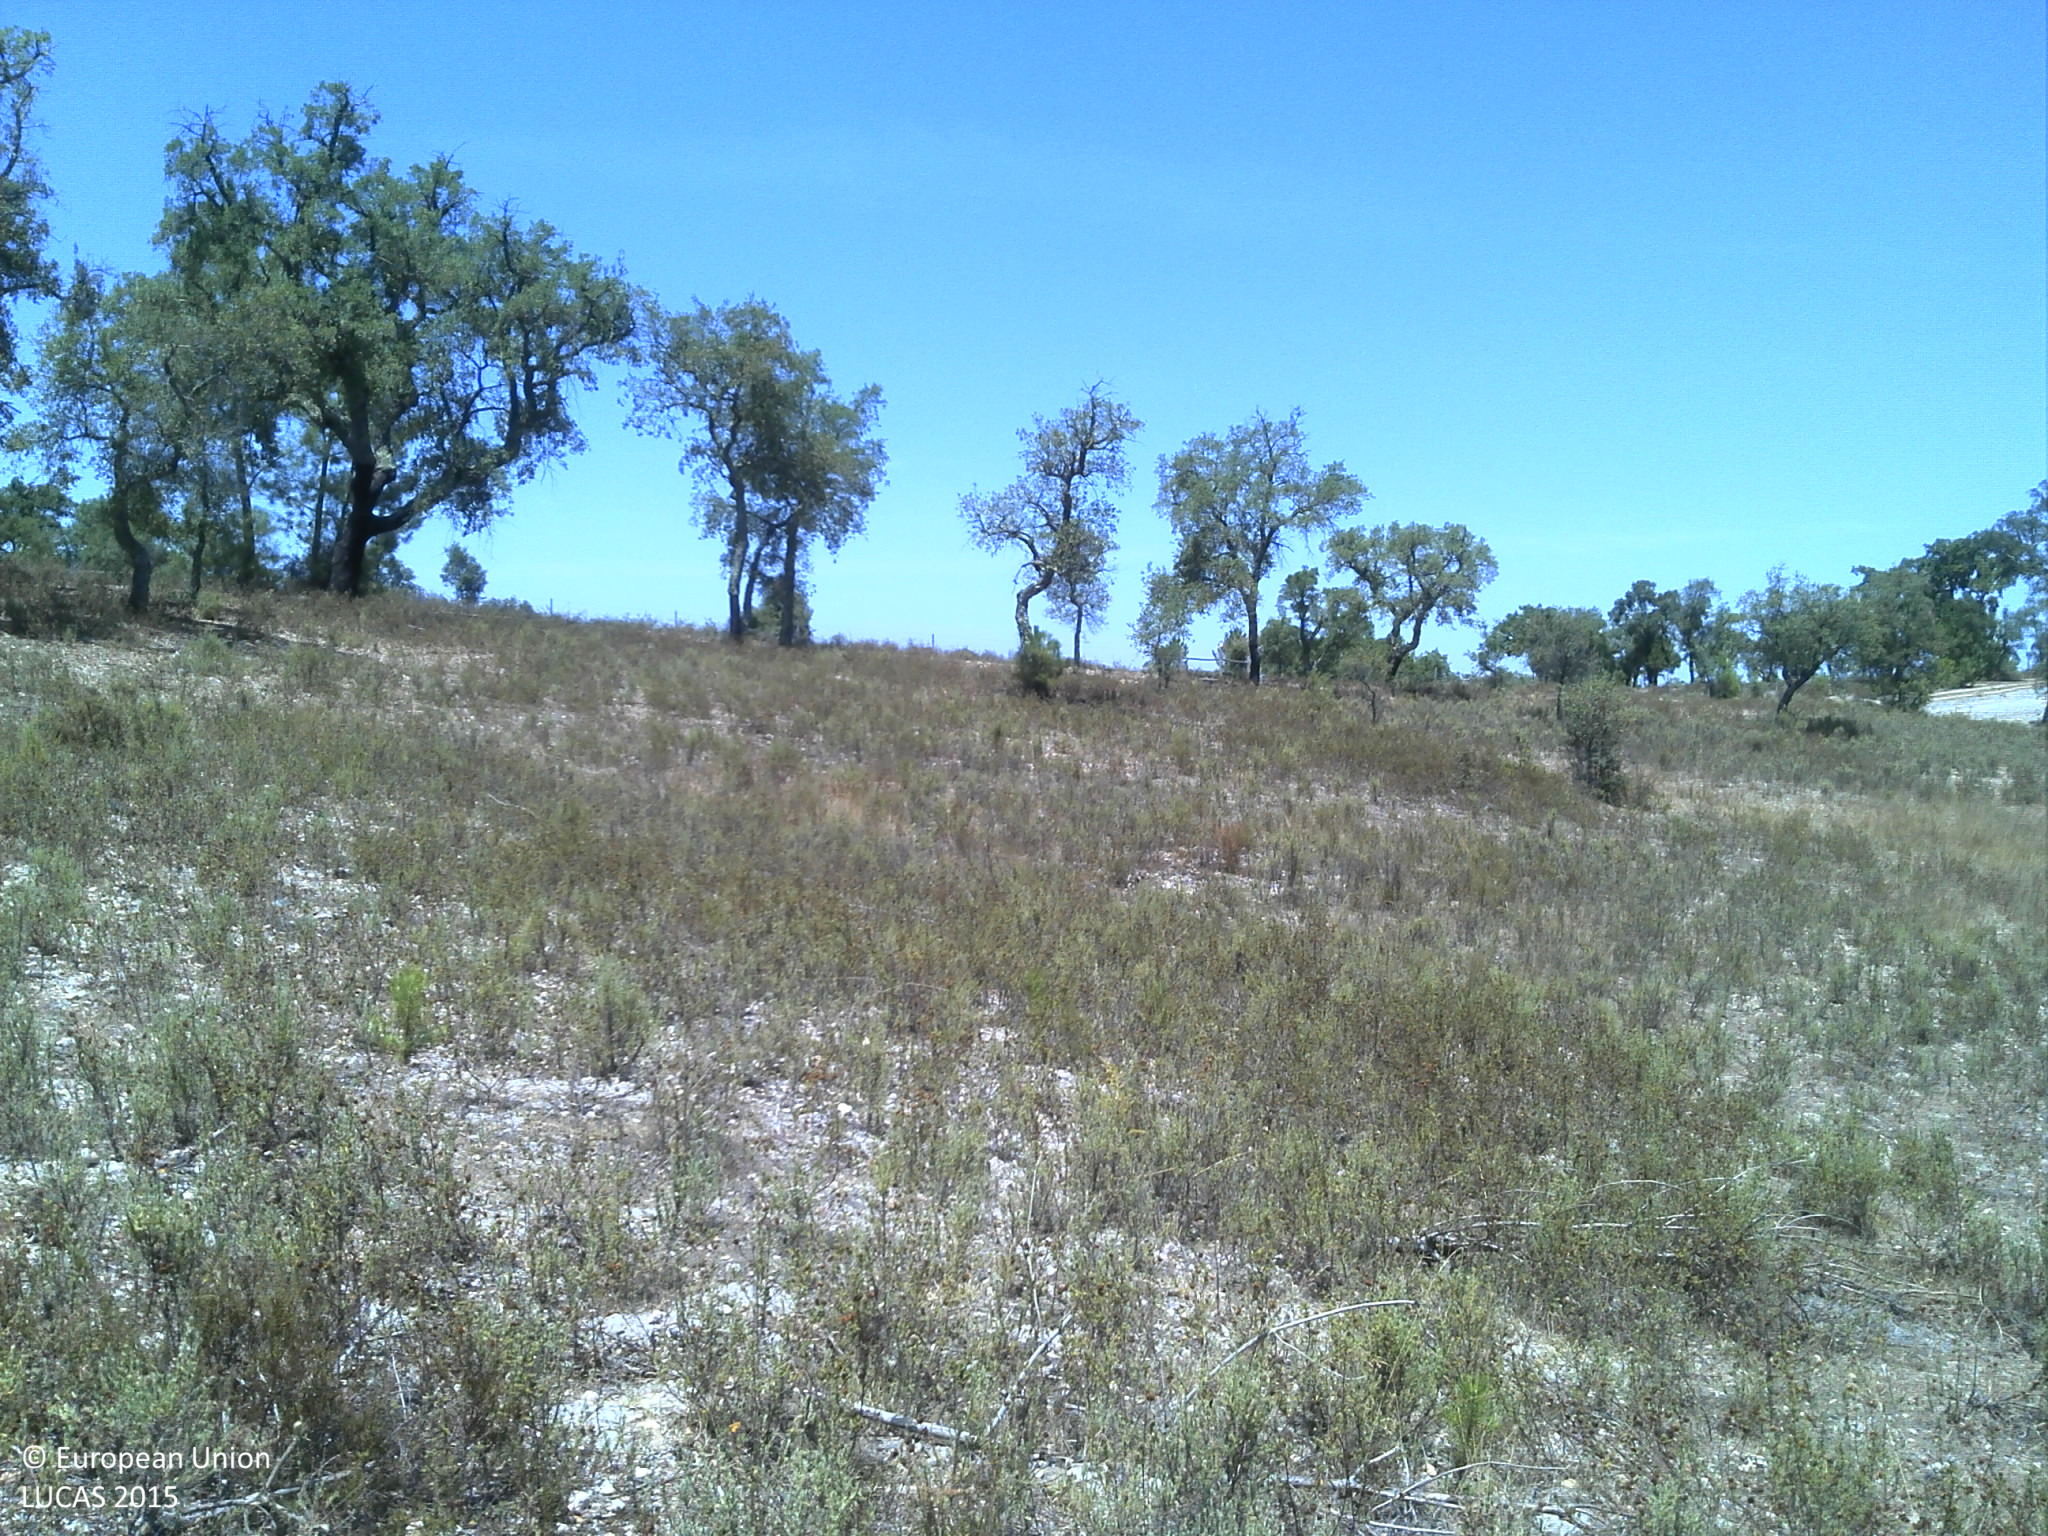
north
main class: Grassland
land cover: Grassland with sparse tree/shrub cover
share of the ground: 25 - 50 %
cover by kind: unconsolidated bare surface 70 %, herbaceous plants 25 %, broadleaved forest trees 5 %
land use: Agriculture (excluding fallow land and kitchen gardens)
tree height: < 5 m
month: July
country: PT
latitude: 39.1604
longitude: -8.1925
